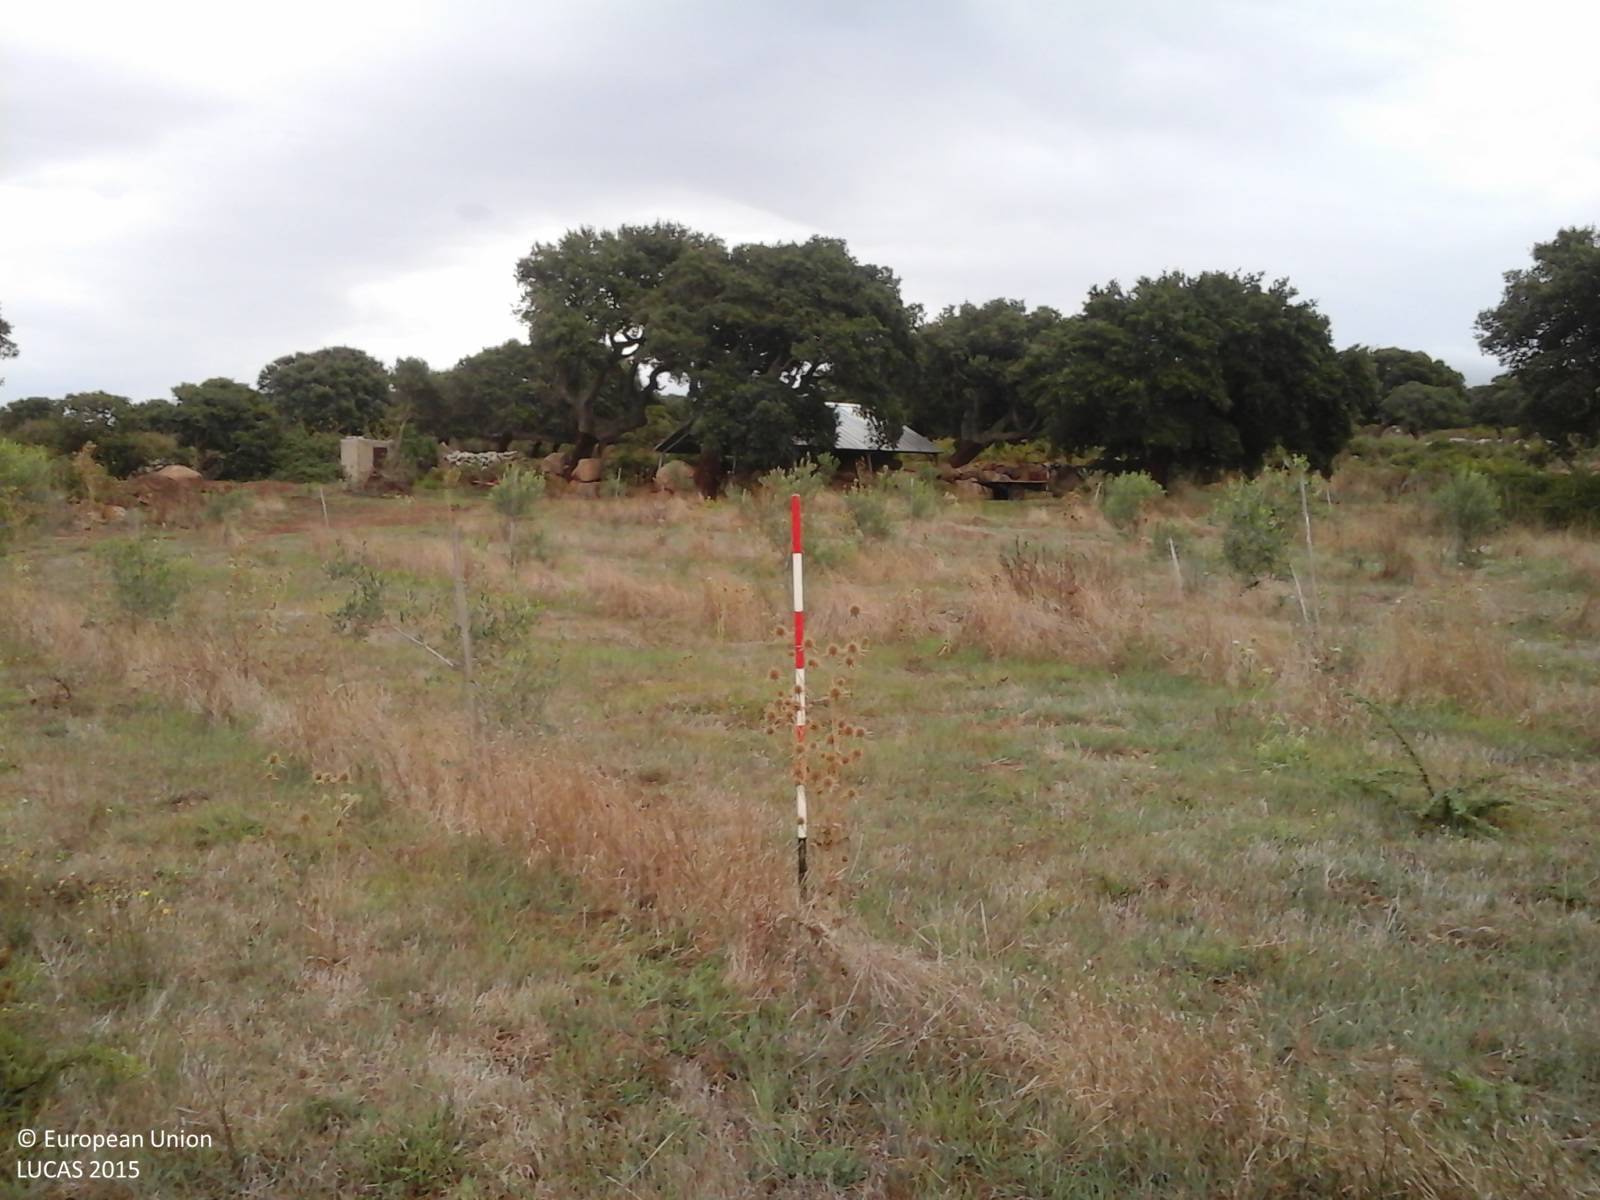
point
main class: Cropland
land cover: Olive groves
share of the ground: 10 - 25 %
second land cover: Grassland without tree/shrub cover
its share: > 75 %
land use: Agriculture (excluding fallow land and kitchen gardens)
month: September
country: IT
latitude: 40.2575
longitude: 8.6081
